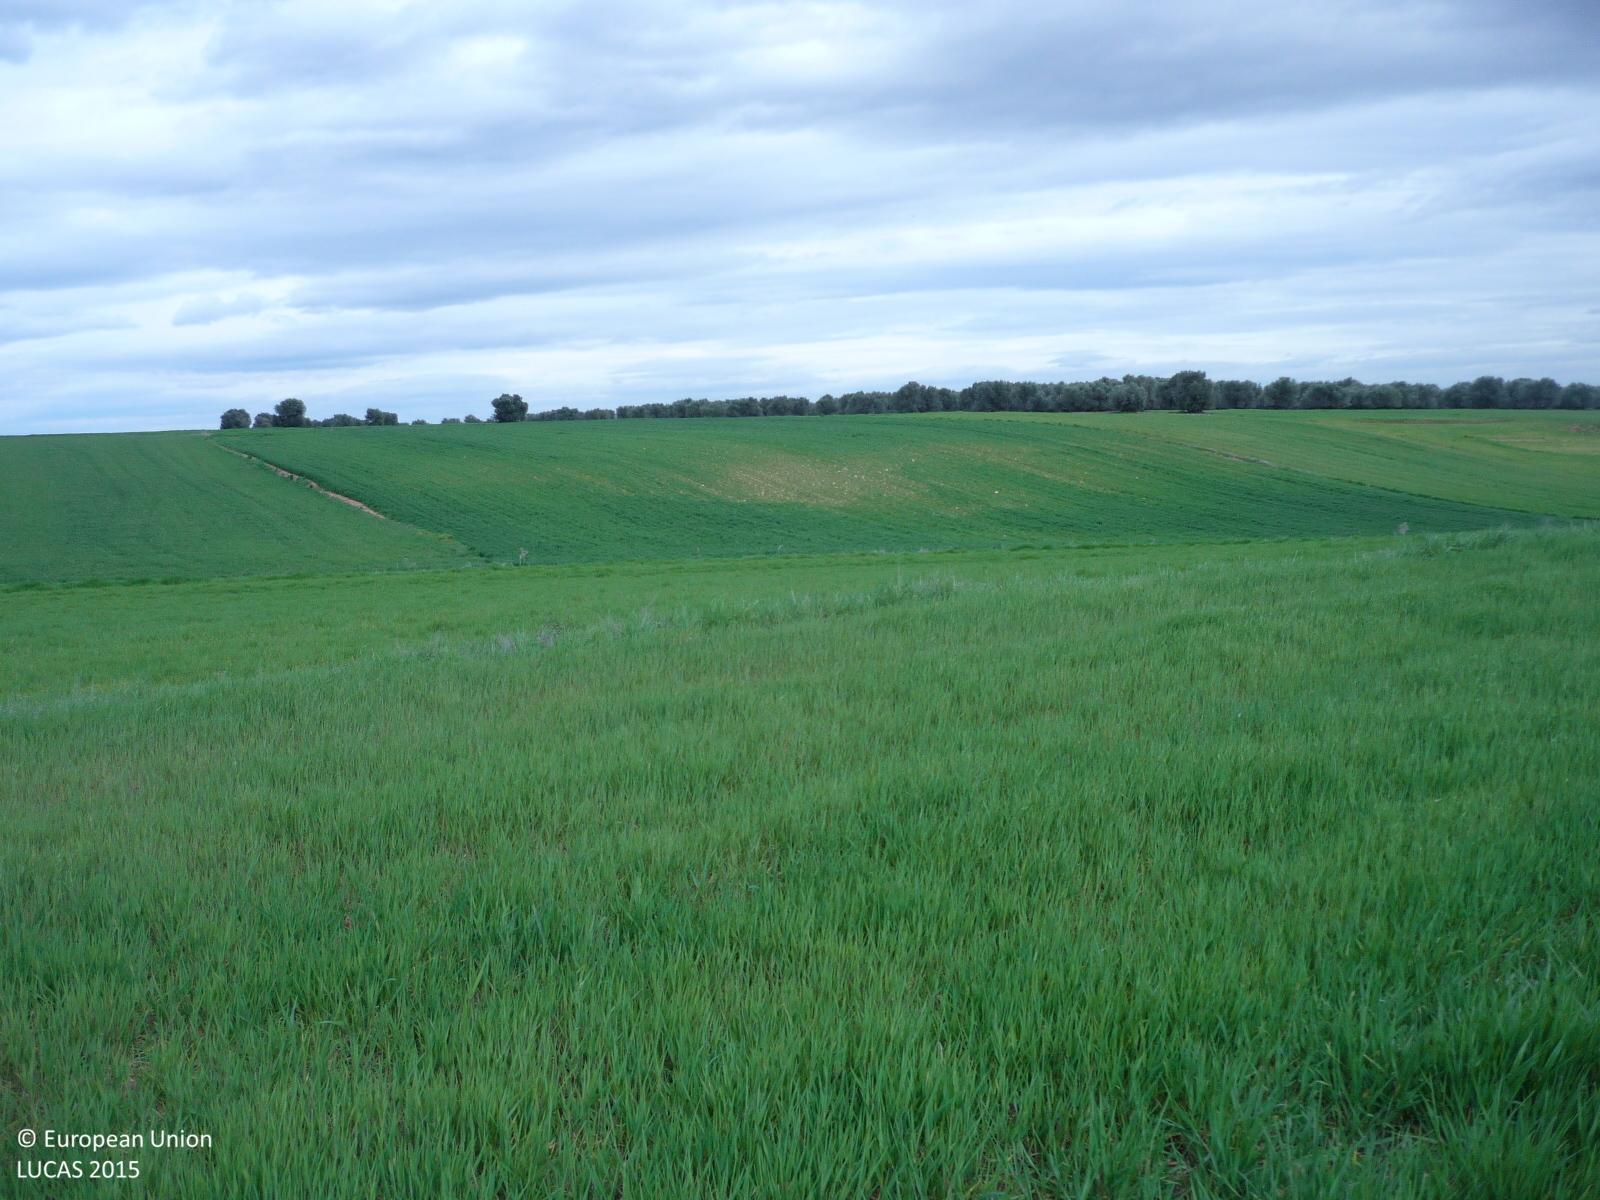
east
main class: Cropland
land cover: Barley
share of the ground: > 75 %
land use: Agriculture (excluding fallow land and kitchen gardens)
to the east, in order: Barley; Grass margins; Barley; Grass margins; Common wheat; Grass margins; Barley
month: March
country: ES
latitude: 40.5371
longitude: -3.5075
